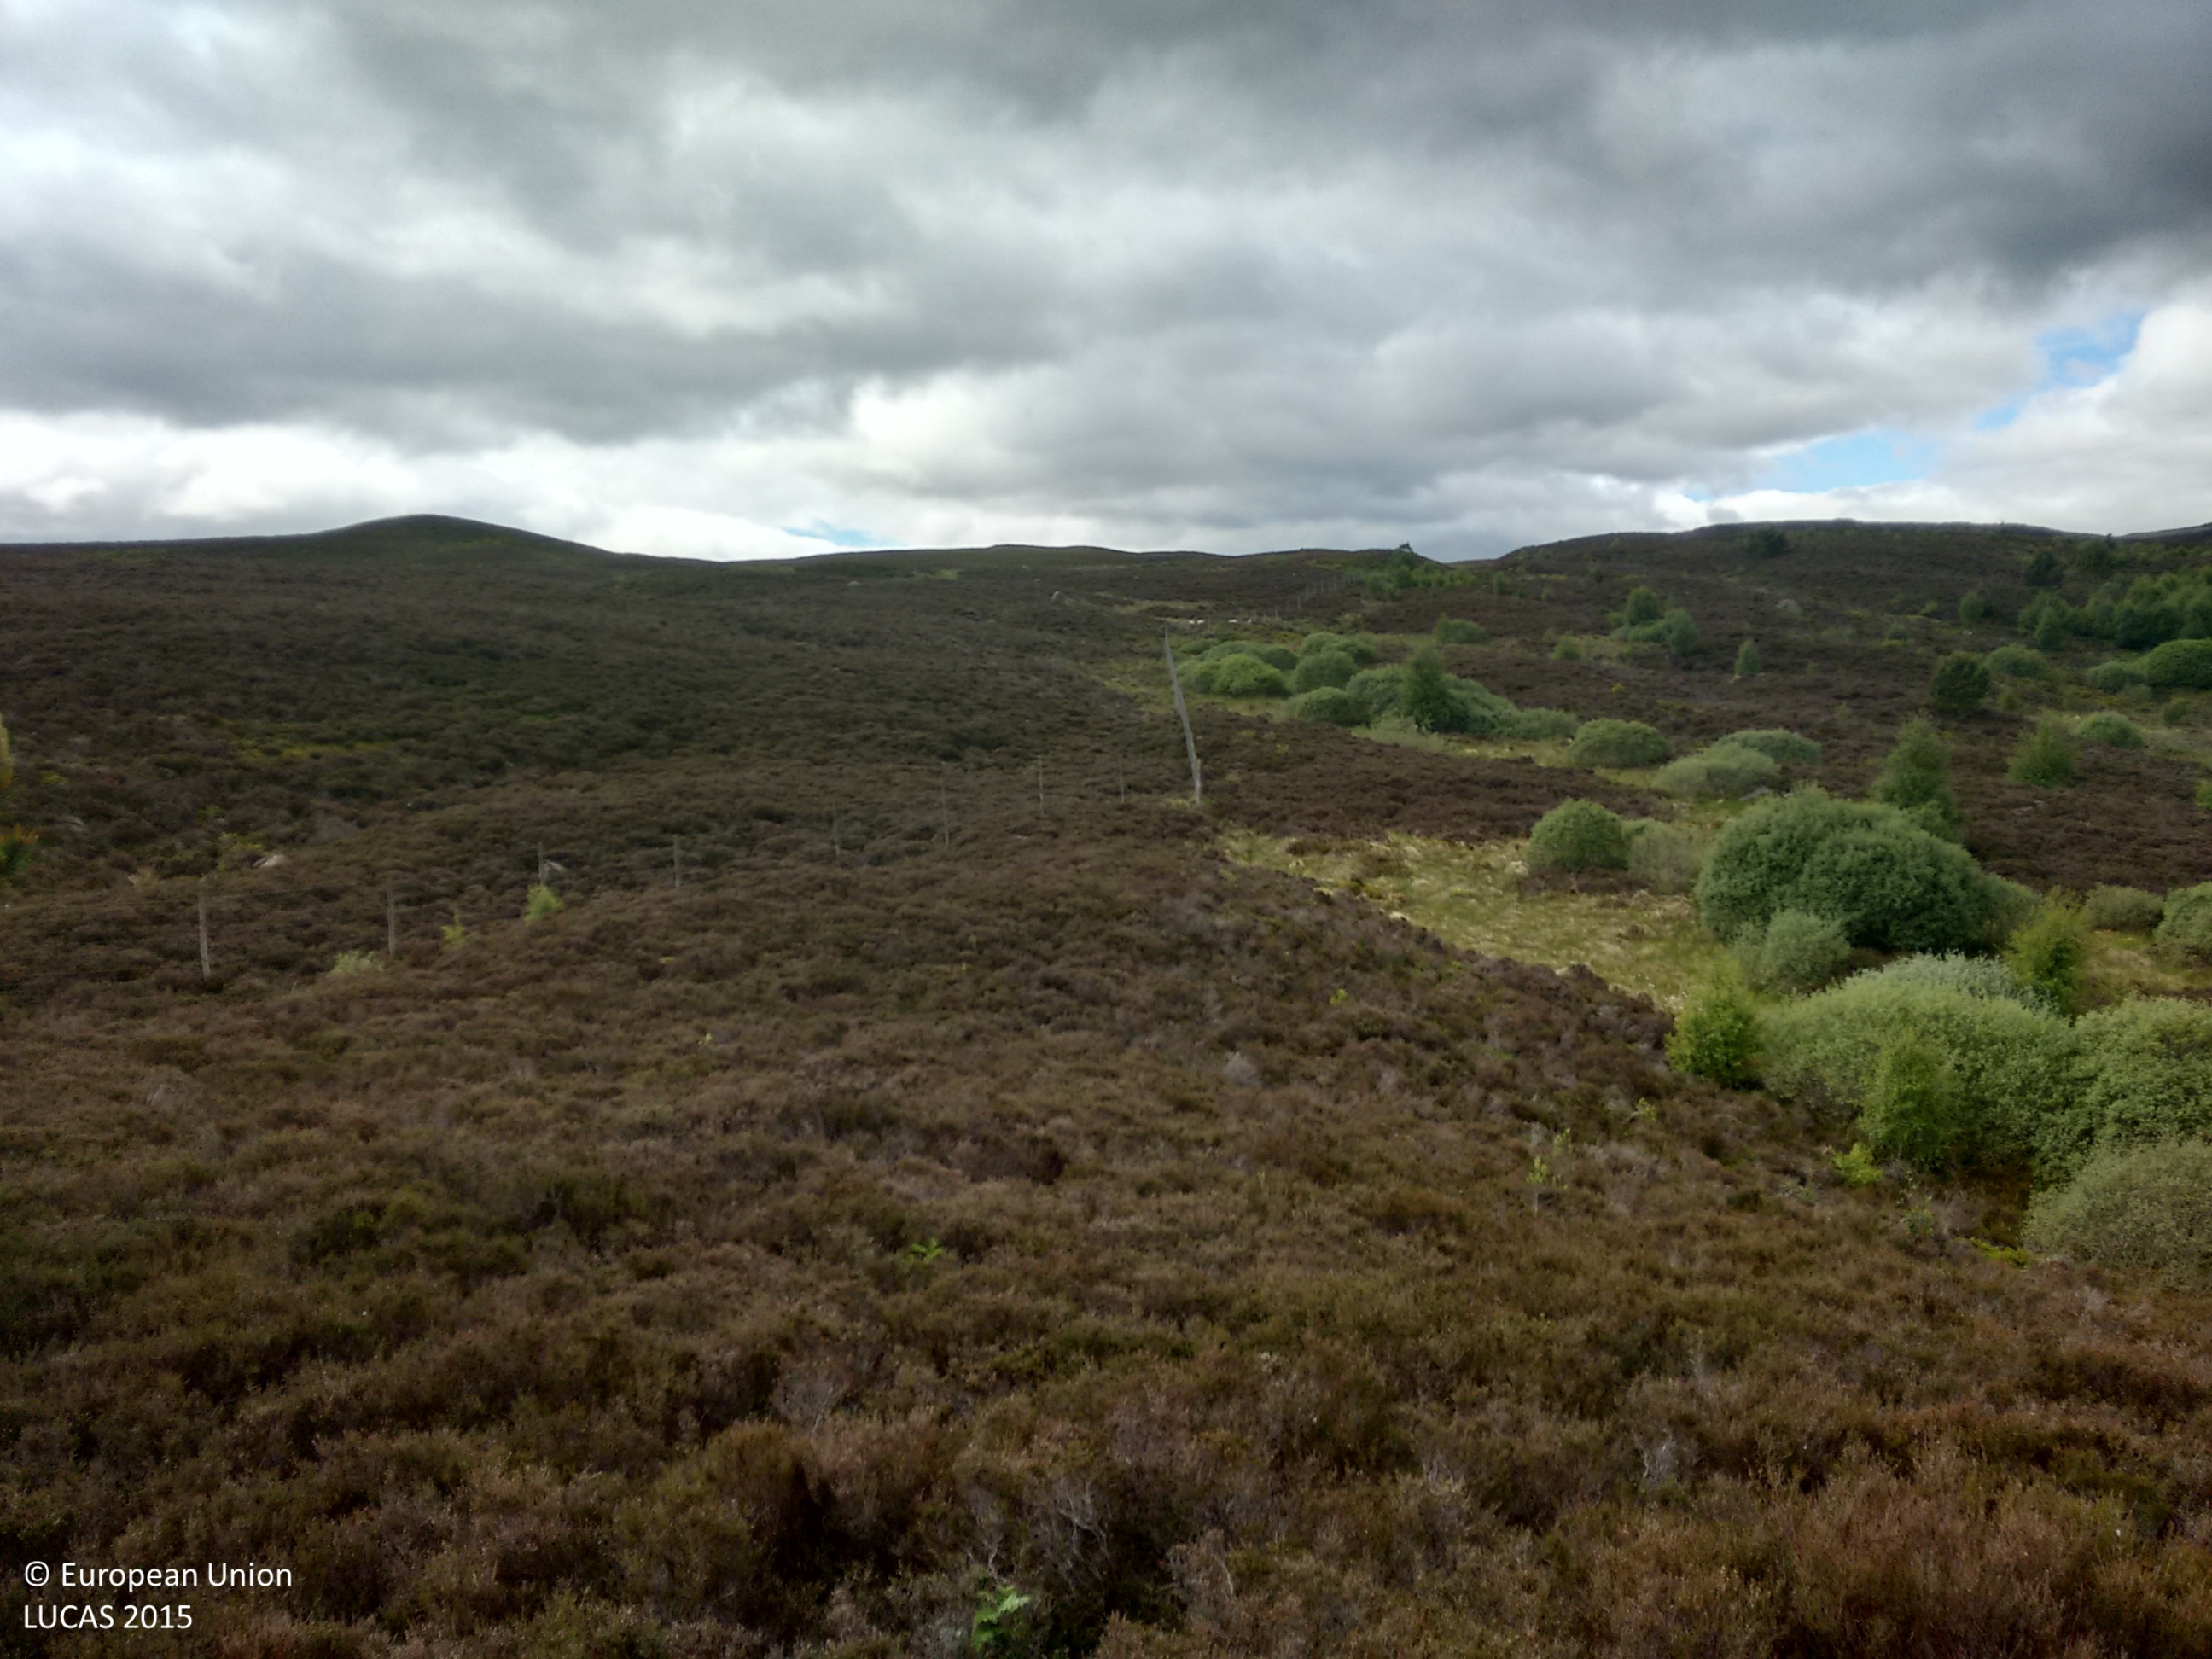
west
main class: Shrubland
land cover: Shrubland without tree cover
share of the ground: > 75 %
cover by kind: shrubs 95 %, herbaceous plants 5 %
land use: Agriculture (excluding fallow land and kitchen gardens)
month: June
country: GB
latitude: 56.6922
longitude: -3.5125
